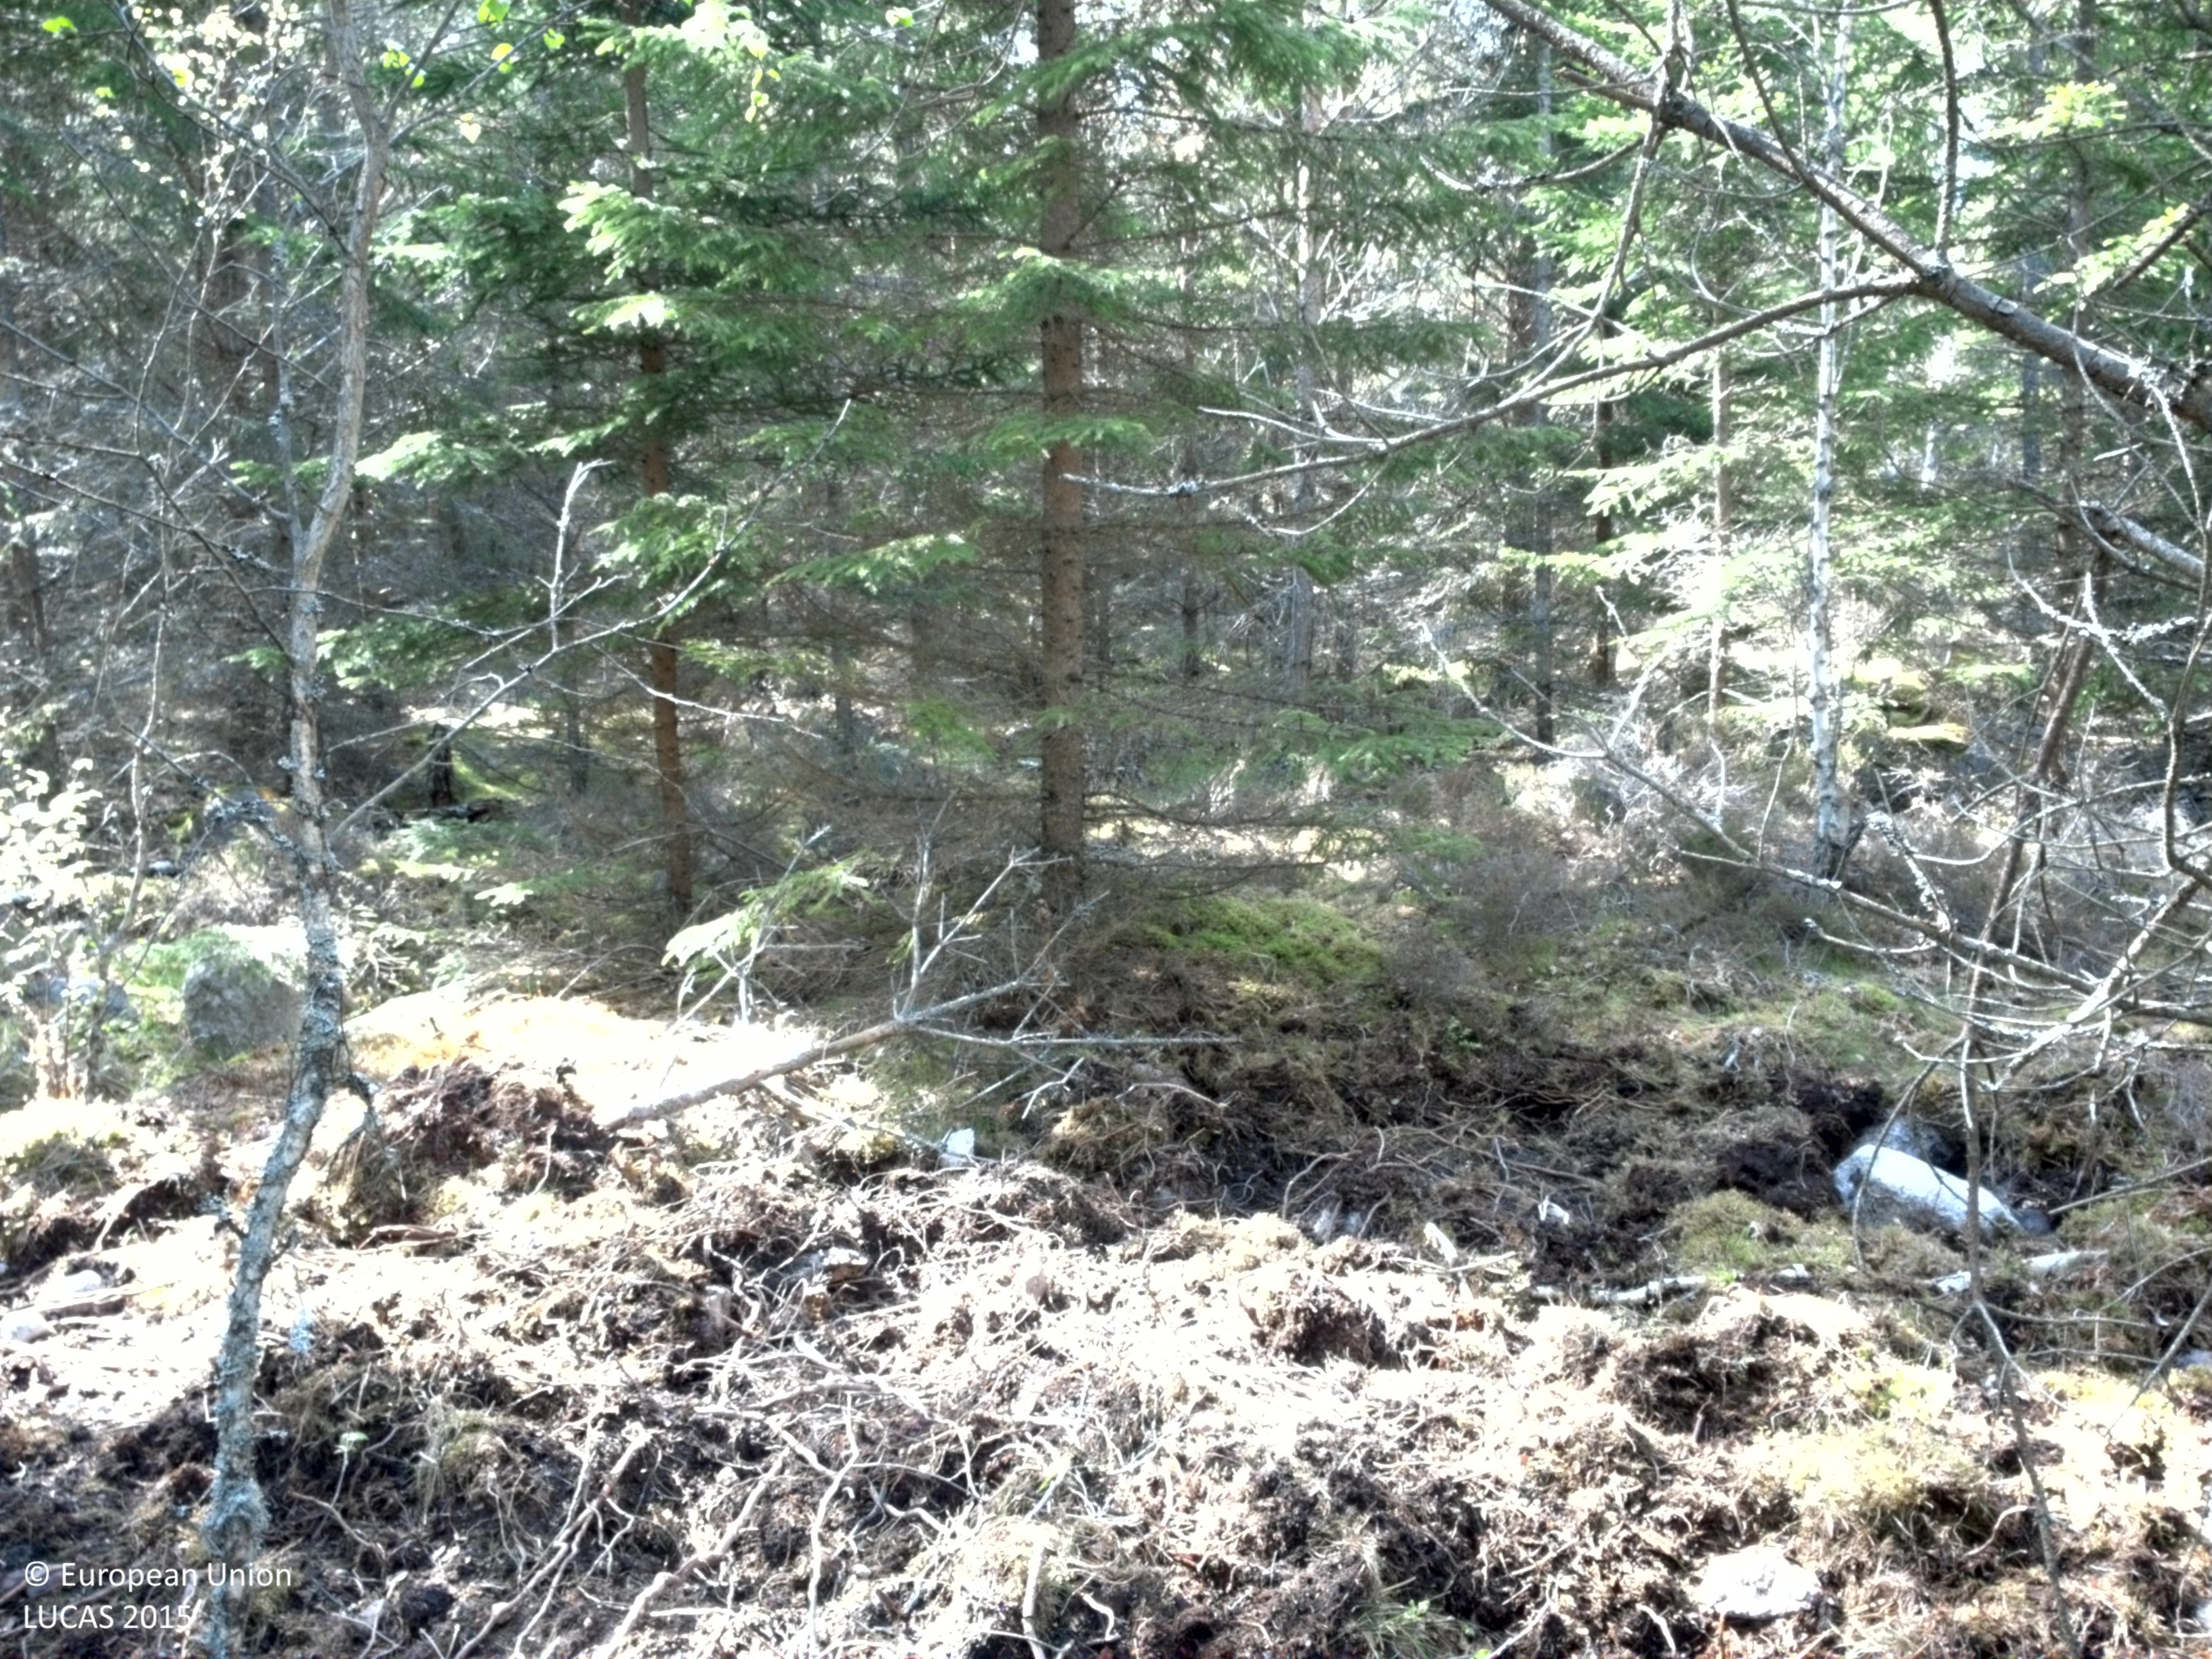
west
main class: Woodland
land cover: Pine dominated coniferous woodland
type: boreal forest
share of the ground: > 75 %
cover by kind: coniferous forest trees 80 %, broadleaved forest trees 10 %, lichens and mosses 10 %
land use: Forestry
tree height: > 5 m
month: May
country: SE
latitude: 56.7652
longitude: 15.2495
